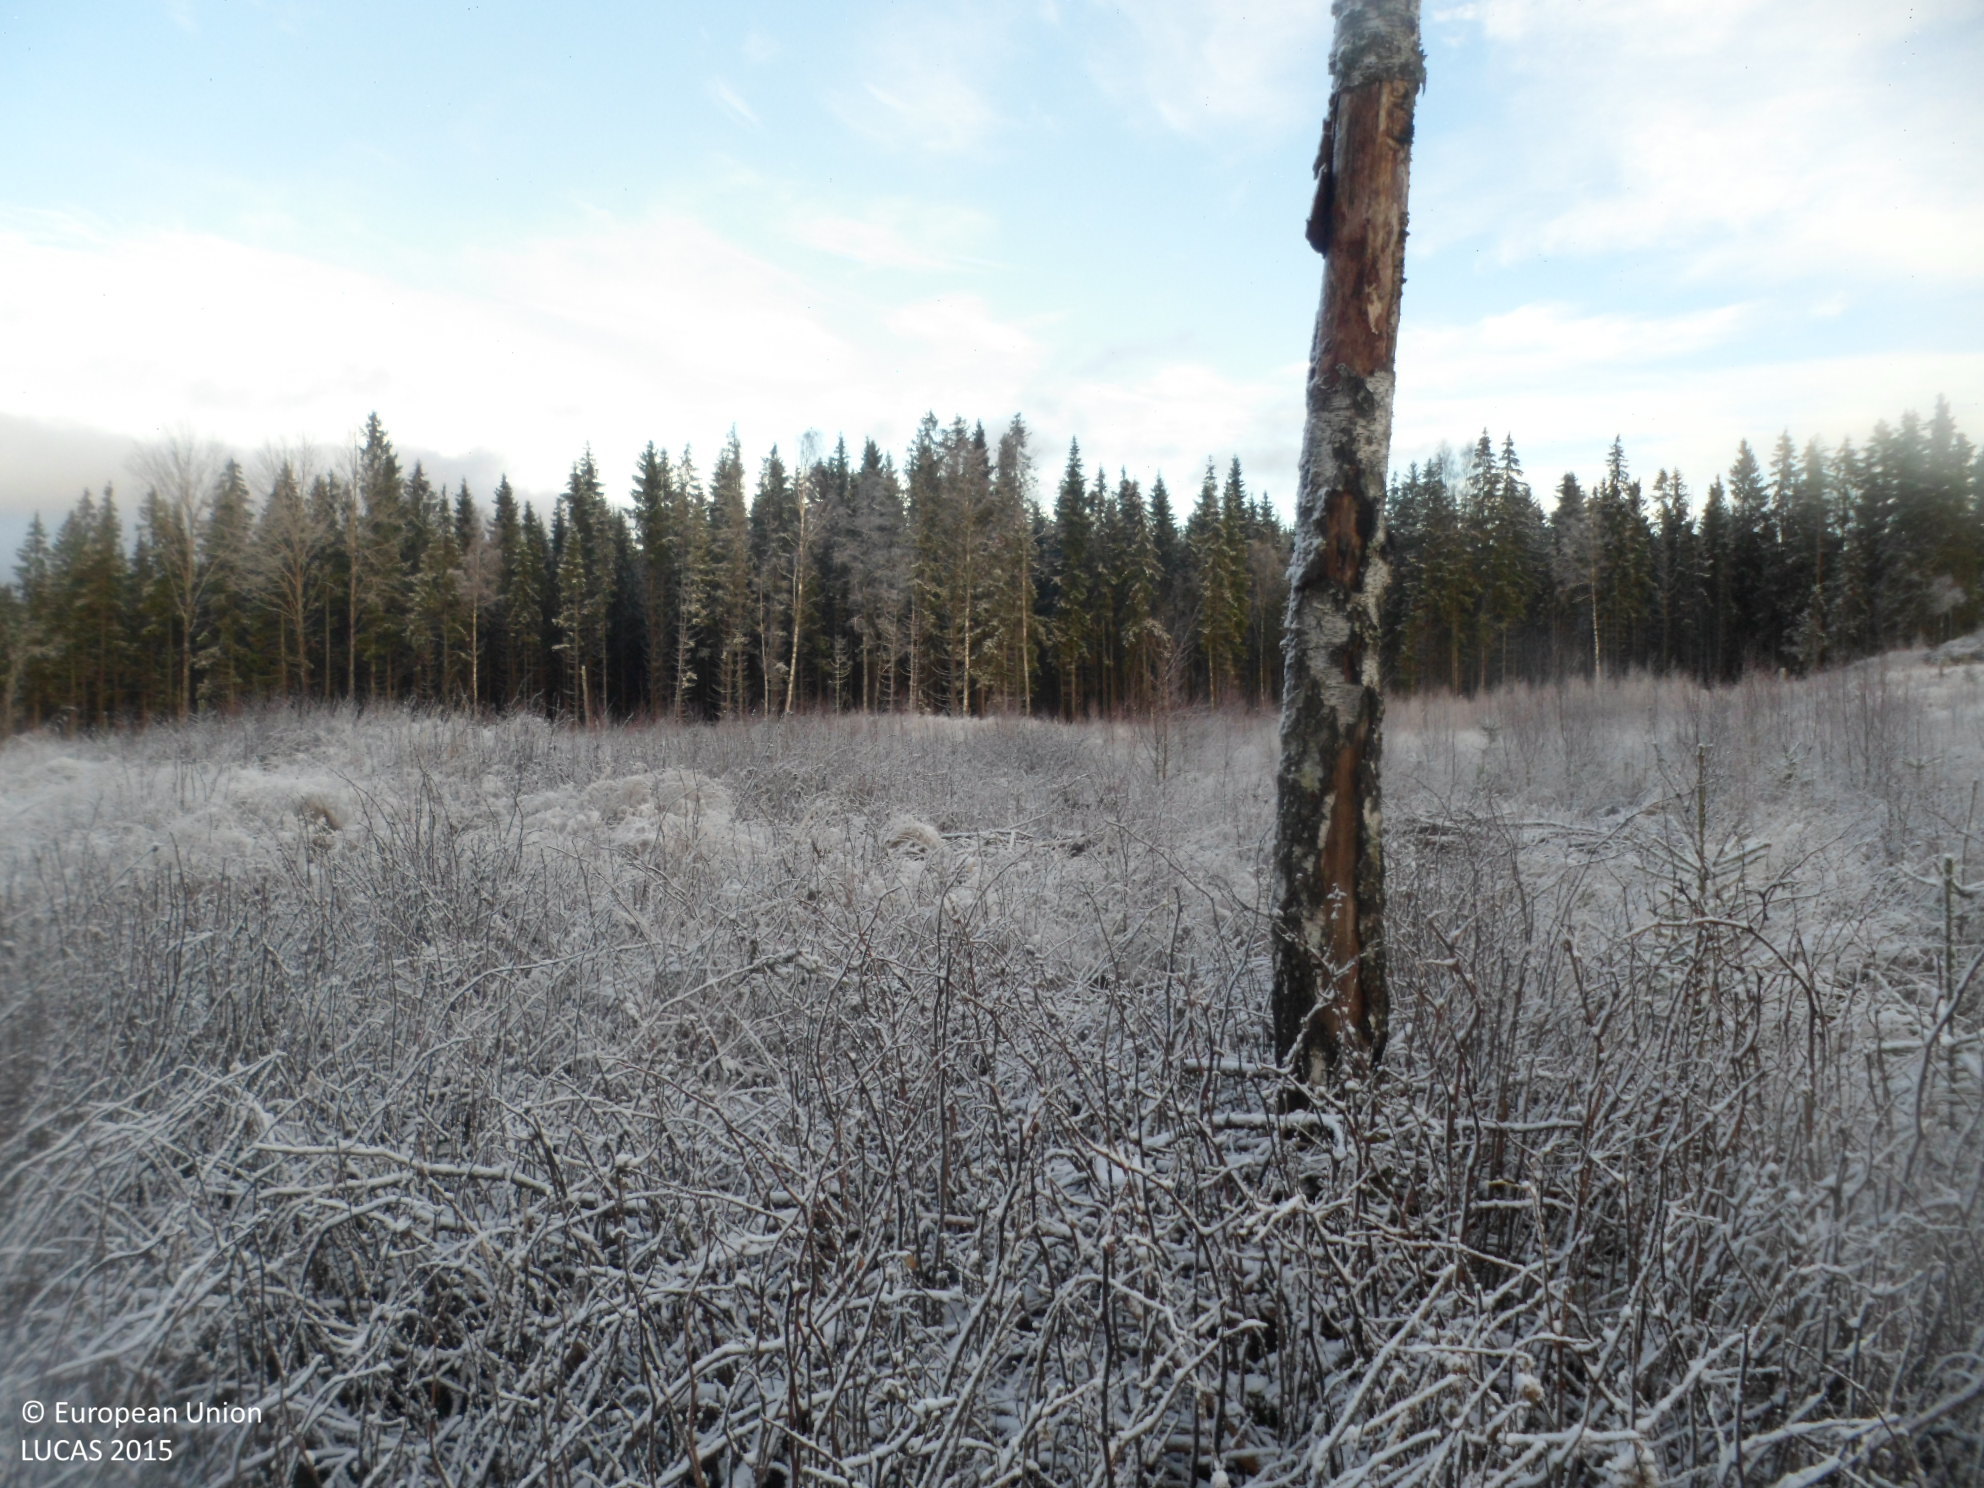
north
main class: Woodland
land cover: Spruce dominated mixed woodland
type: boreal forest
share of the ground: 10 - 25 %
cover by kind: herbaceous plants 60 %, shrubs 20 %, broadleaved forest trees 10 %, coniferous forest trees 5 %, lichens and mosses 5 %
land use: Forestry
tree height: < 5 m
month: November
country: SE
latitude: 57.8236
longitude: 14.3893
